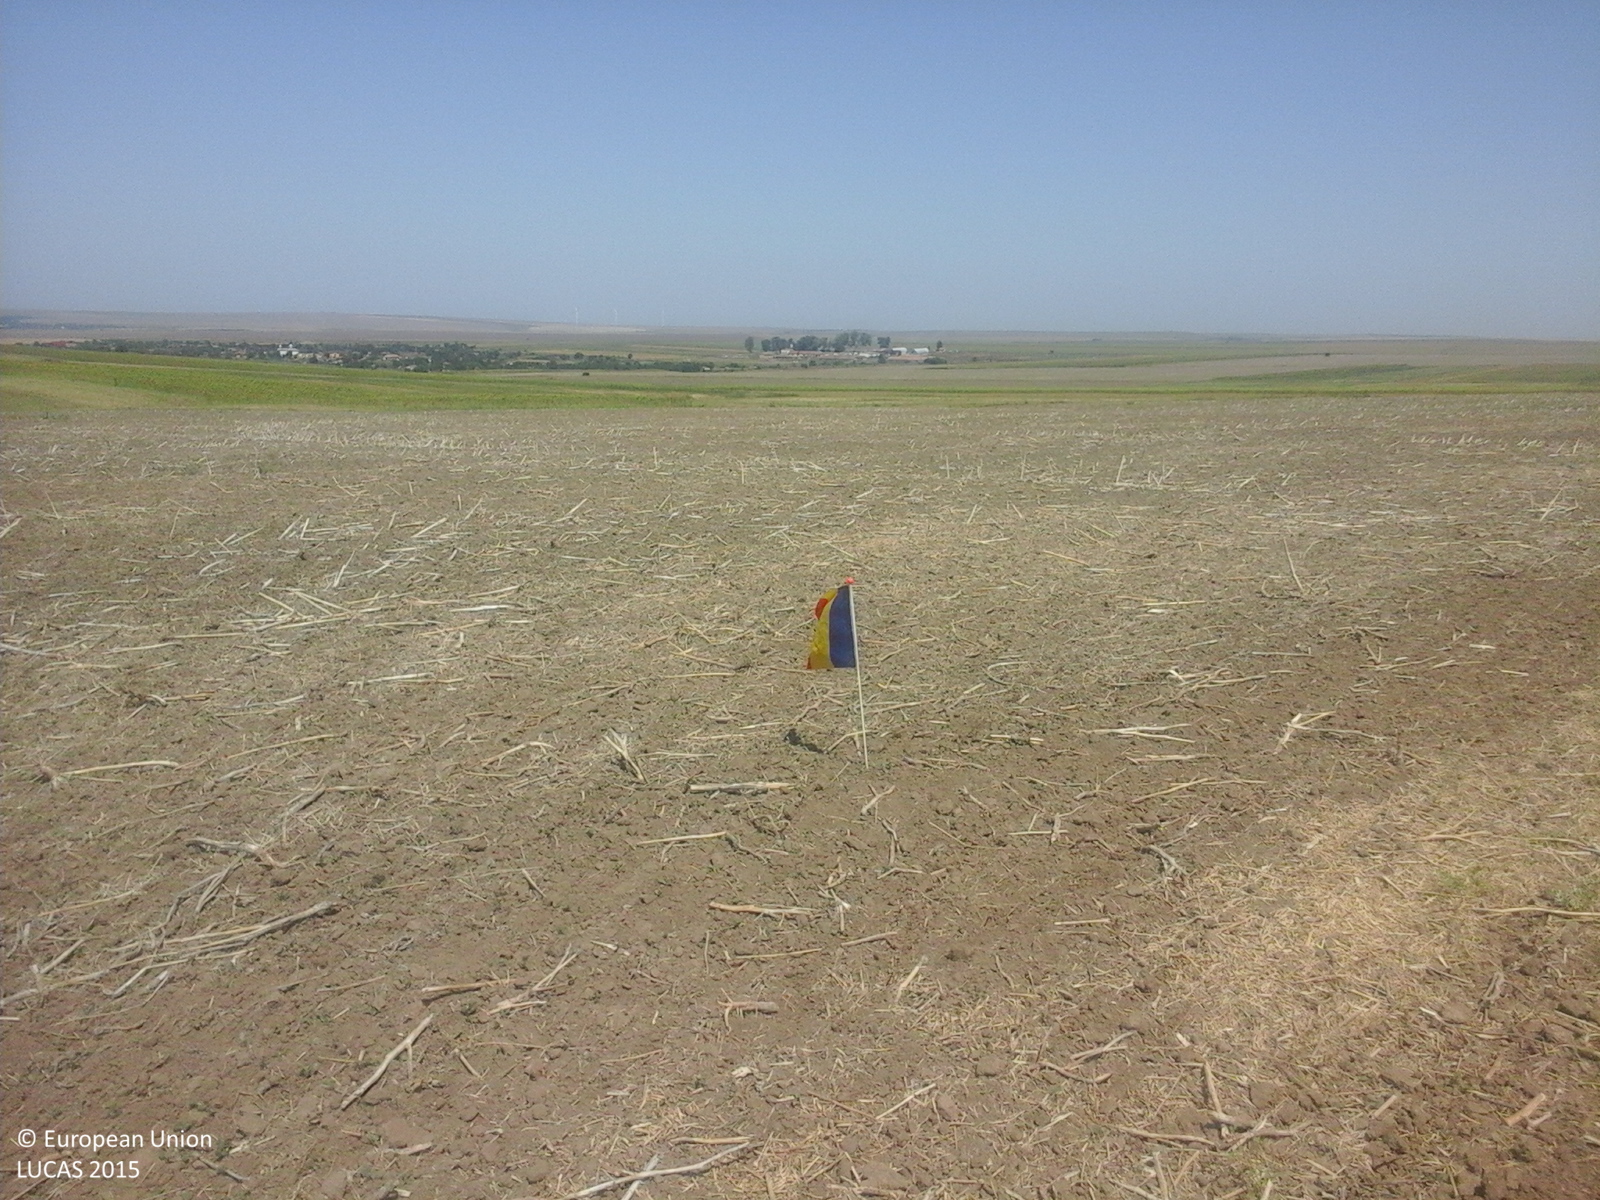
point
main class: Cropland
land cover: Rape and turnip rape
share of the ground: < 10 %
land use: Agriculture (excluding fallow land and kitchen gardens)
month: August
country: RO
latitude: 44.5898
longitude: 28.1902
